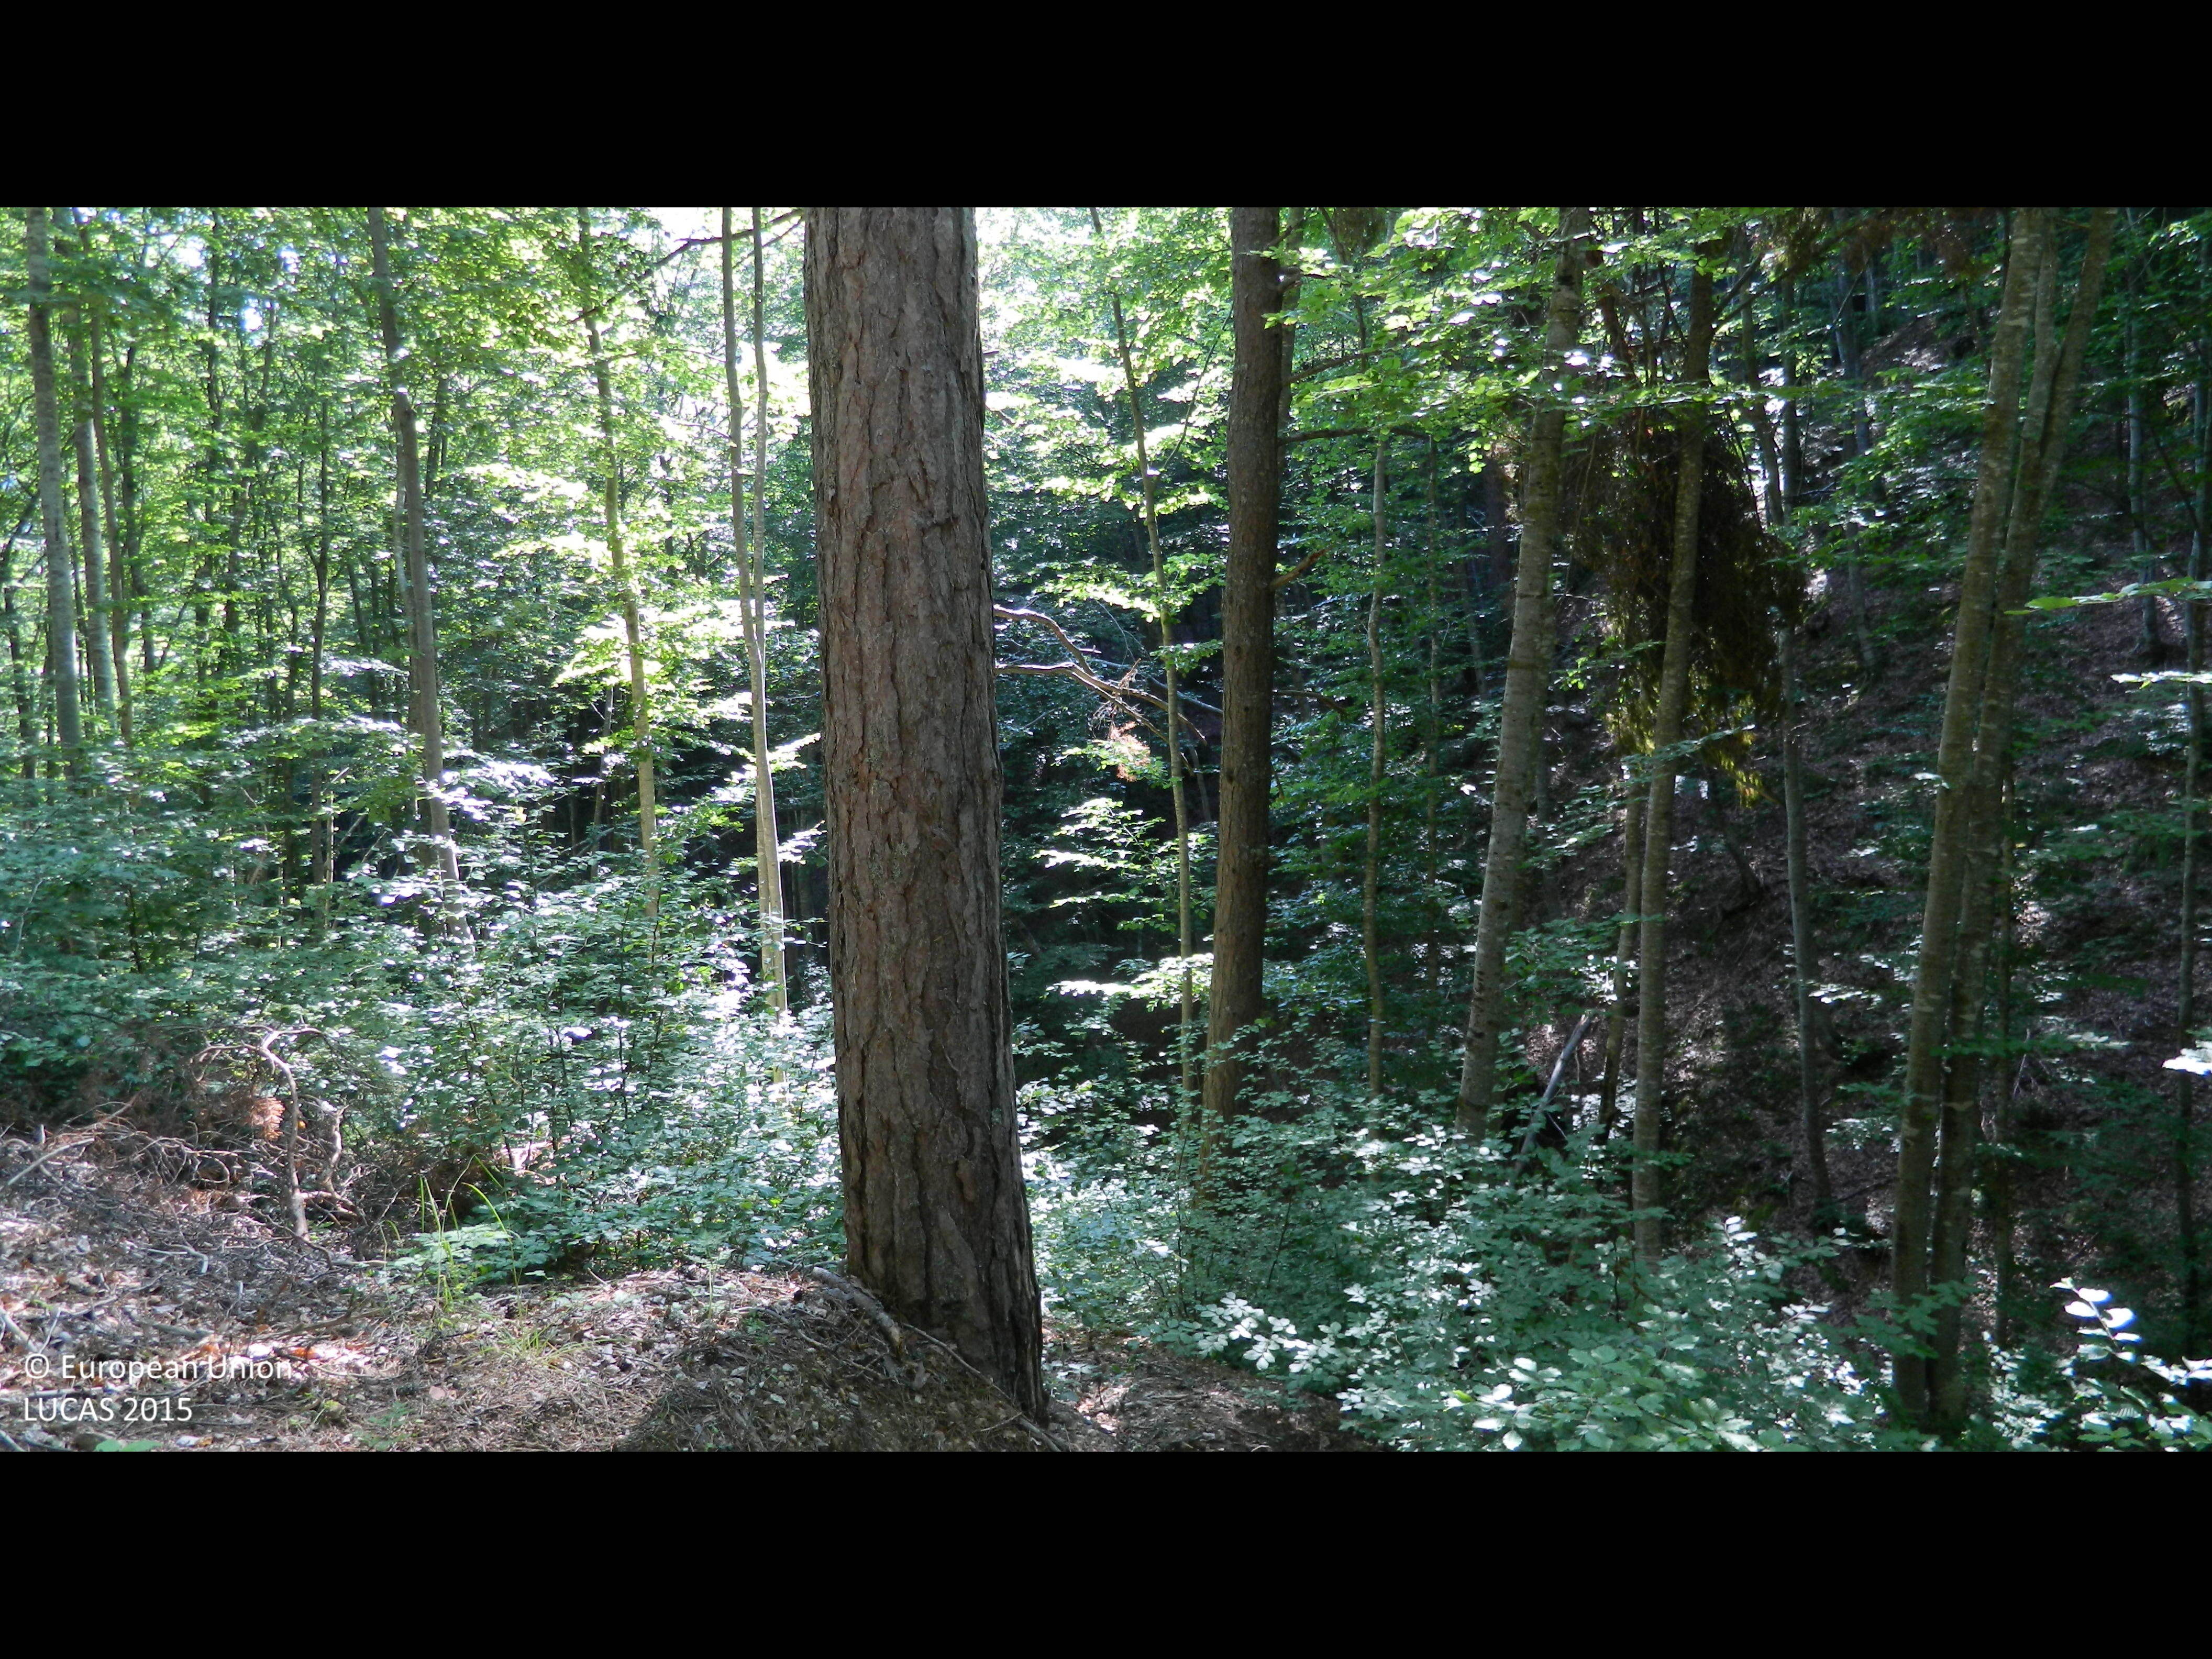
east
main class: Woodland
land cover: Broadleaved woodland
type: mountainous beech forest
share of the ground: > 75 %
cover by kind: broadleaved forest trees 85 %, coniferous forest trees 10 %, unconsolidated bare surface 5 %
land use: Forestry
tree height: > 5 m
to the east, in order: Broadleaved woodland; Rivers and streams; Broadleaved woodland; Tracks; Broadleaved woodland
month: July
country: BG
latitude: 41.5413
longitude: 24.8012
